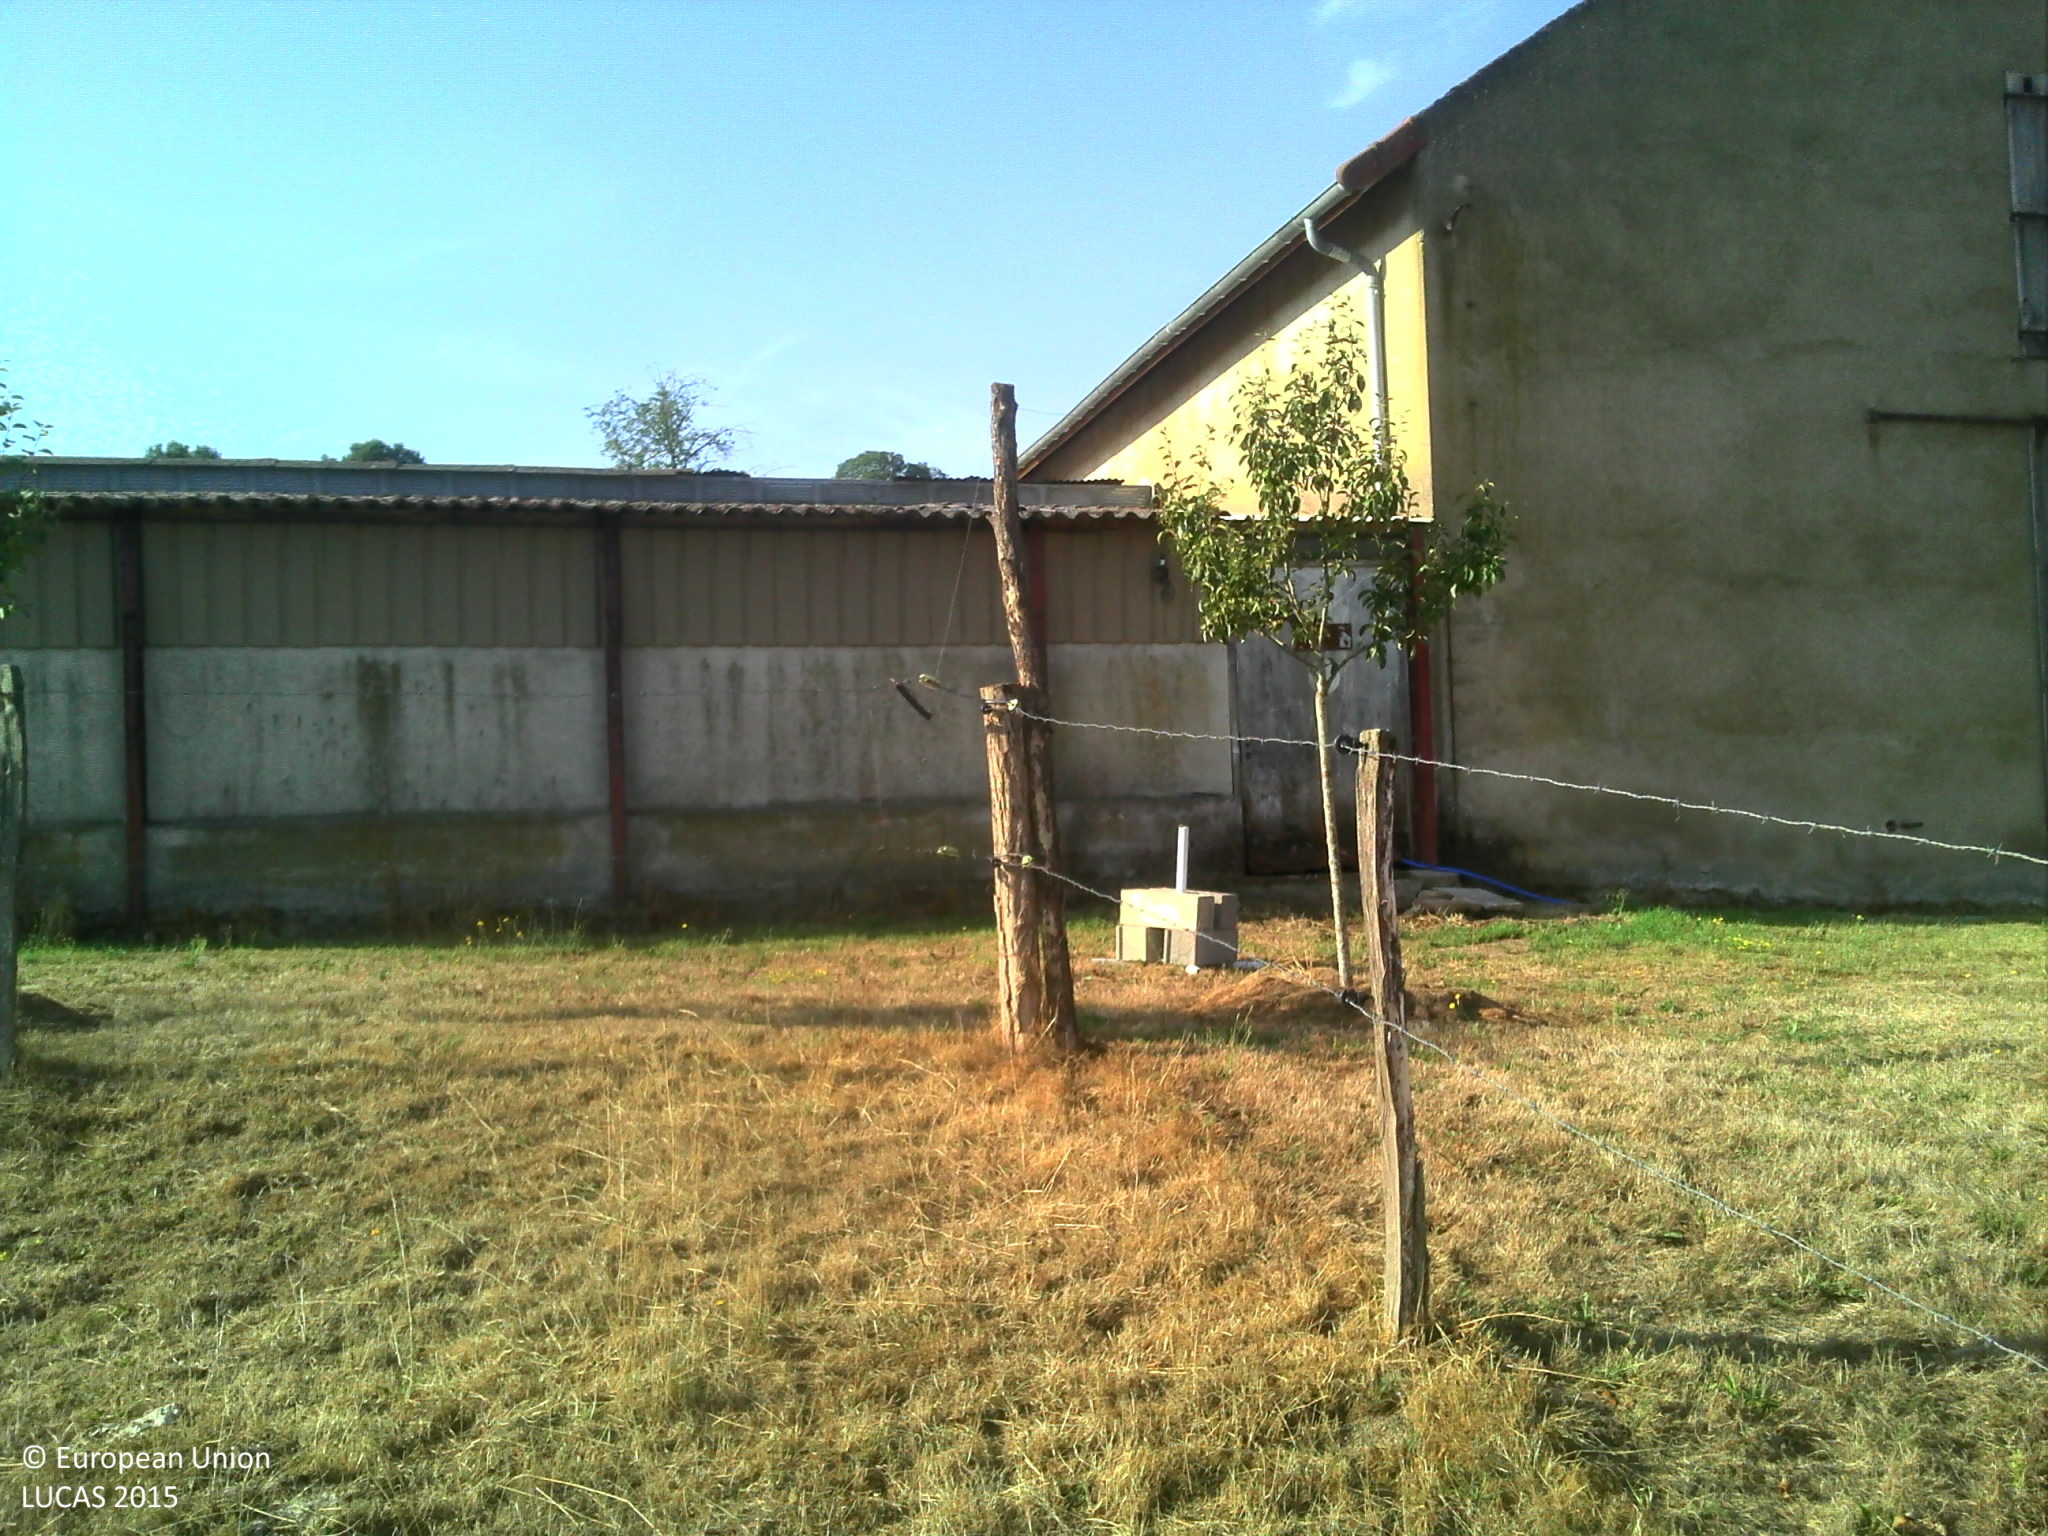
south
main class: Grassland
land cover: Grassland without tree/shrub cover
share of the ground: > 75 %
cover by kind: herbaceous plants 100 %
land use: Agriculture (excluding fallow land and kitchen gardens)
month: August
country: FR
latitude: 46.7121
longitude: 4.4412
